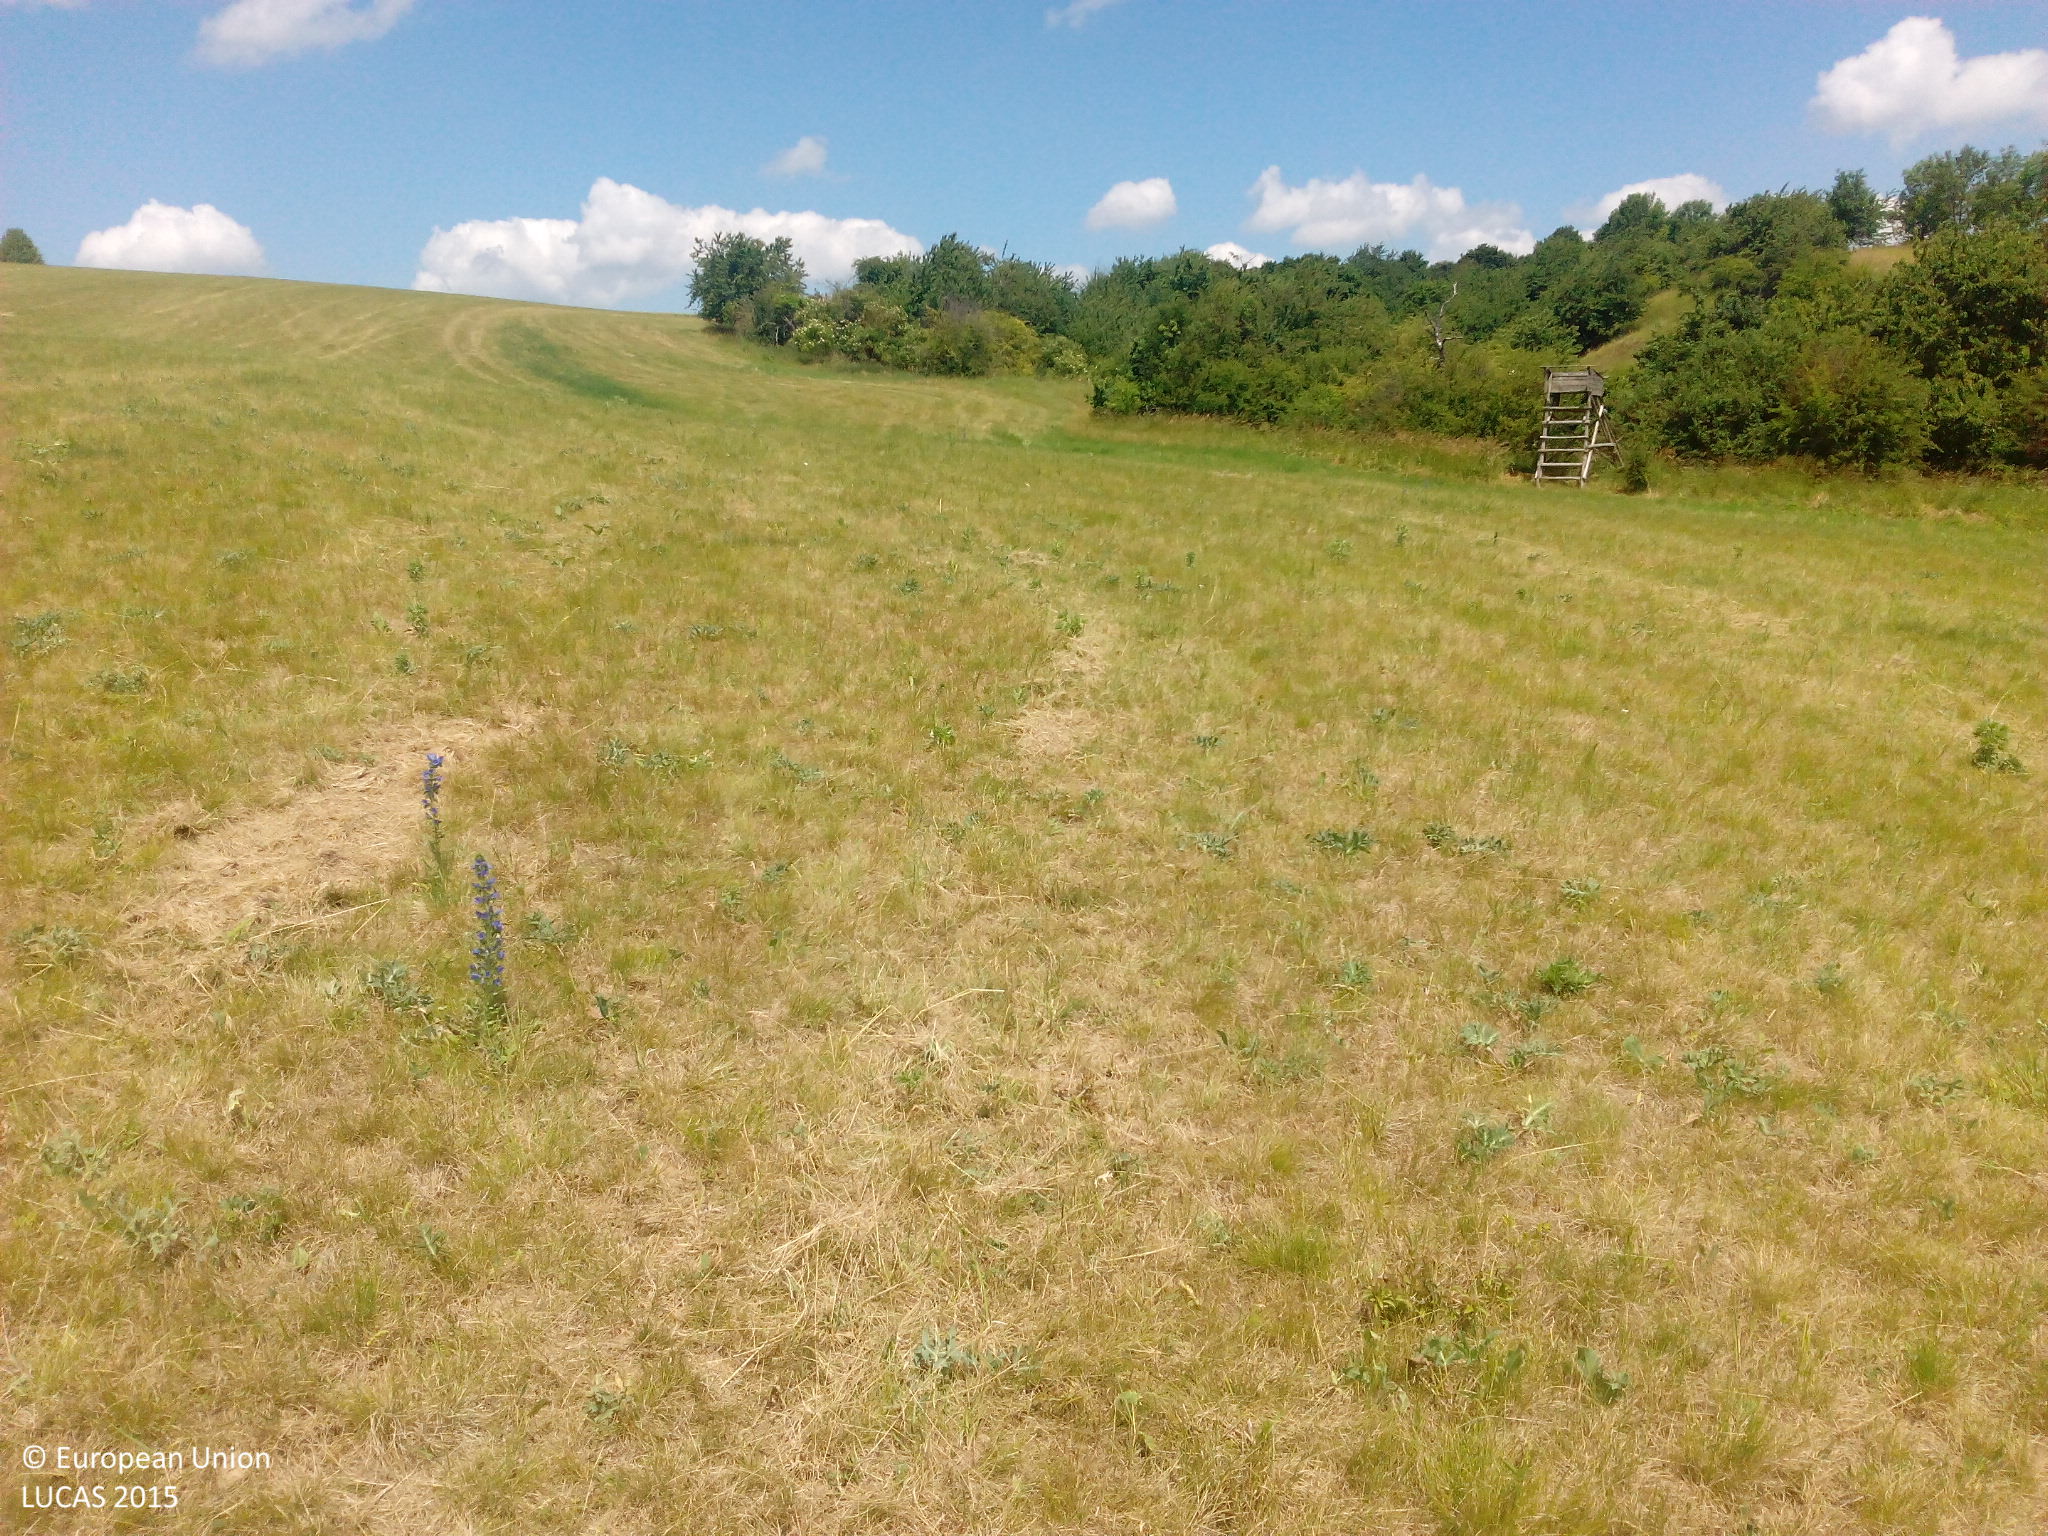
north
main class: Grassland
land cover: Grassland without tree/shrub cover
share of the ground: > 75 %
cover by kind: herbaceous plants 100 %
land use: Agriculture (excluding fallow land and kitchen gardens)
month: June
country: DE
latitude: 51.5764
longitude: 11.5436
